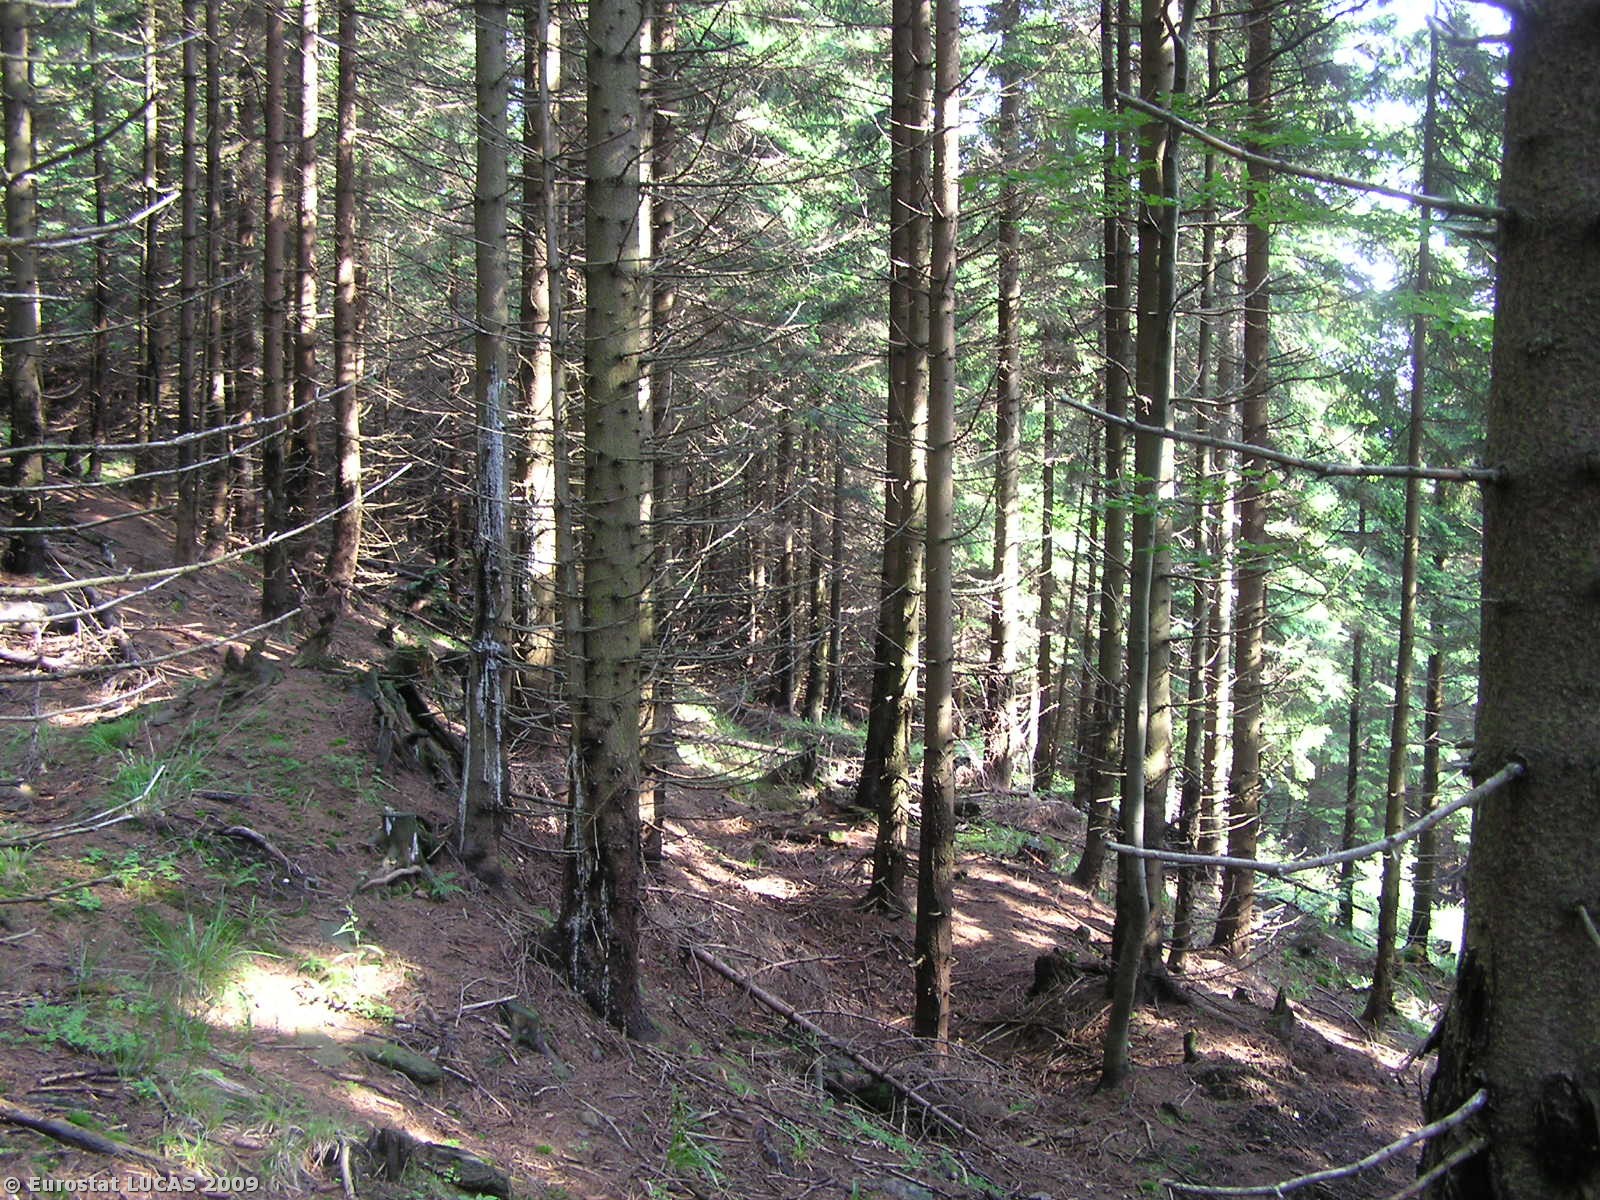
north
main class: Woodland
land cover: Coniferous woodland
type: hemiboreal forest and nemoral coniferous forest and mixed broadleaved-coniferous forest
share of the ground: > 75 %
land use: Forestry
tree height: > 5 m
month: July
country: CZ
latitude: 50.1771
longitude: 17.1380
